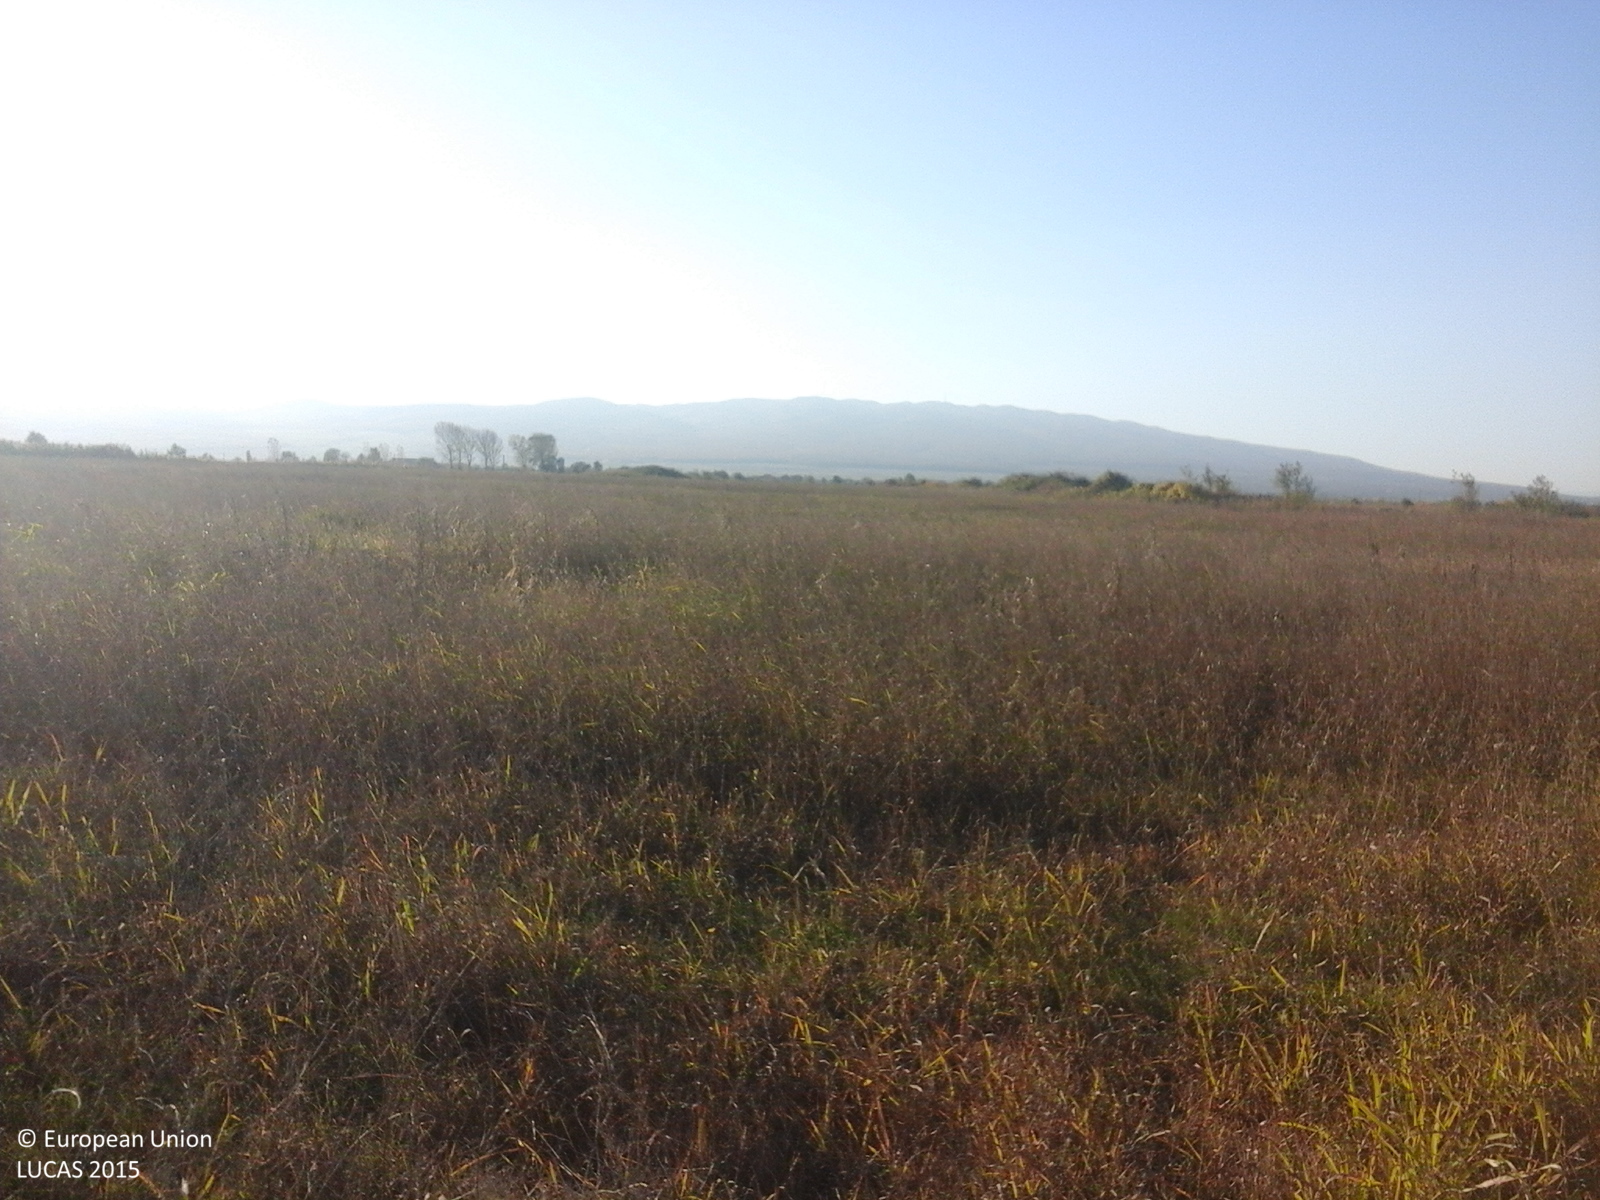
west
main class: Grassland
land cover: Spontaneously vegetated surfaces
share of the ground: > 75 %
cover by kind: herbaceous plants 100 %
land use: Fallow land
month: October
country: RO
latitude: 45.8219
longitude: 27.1227
